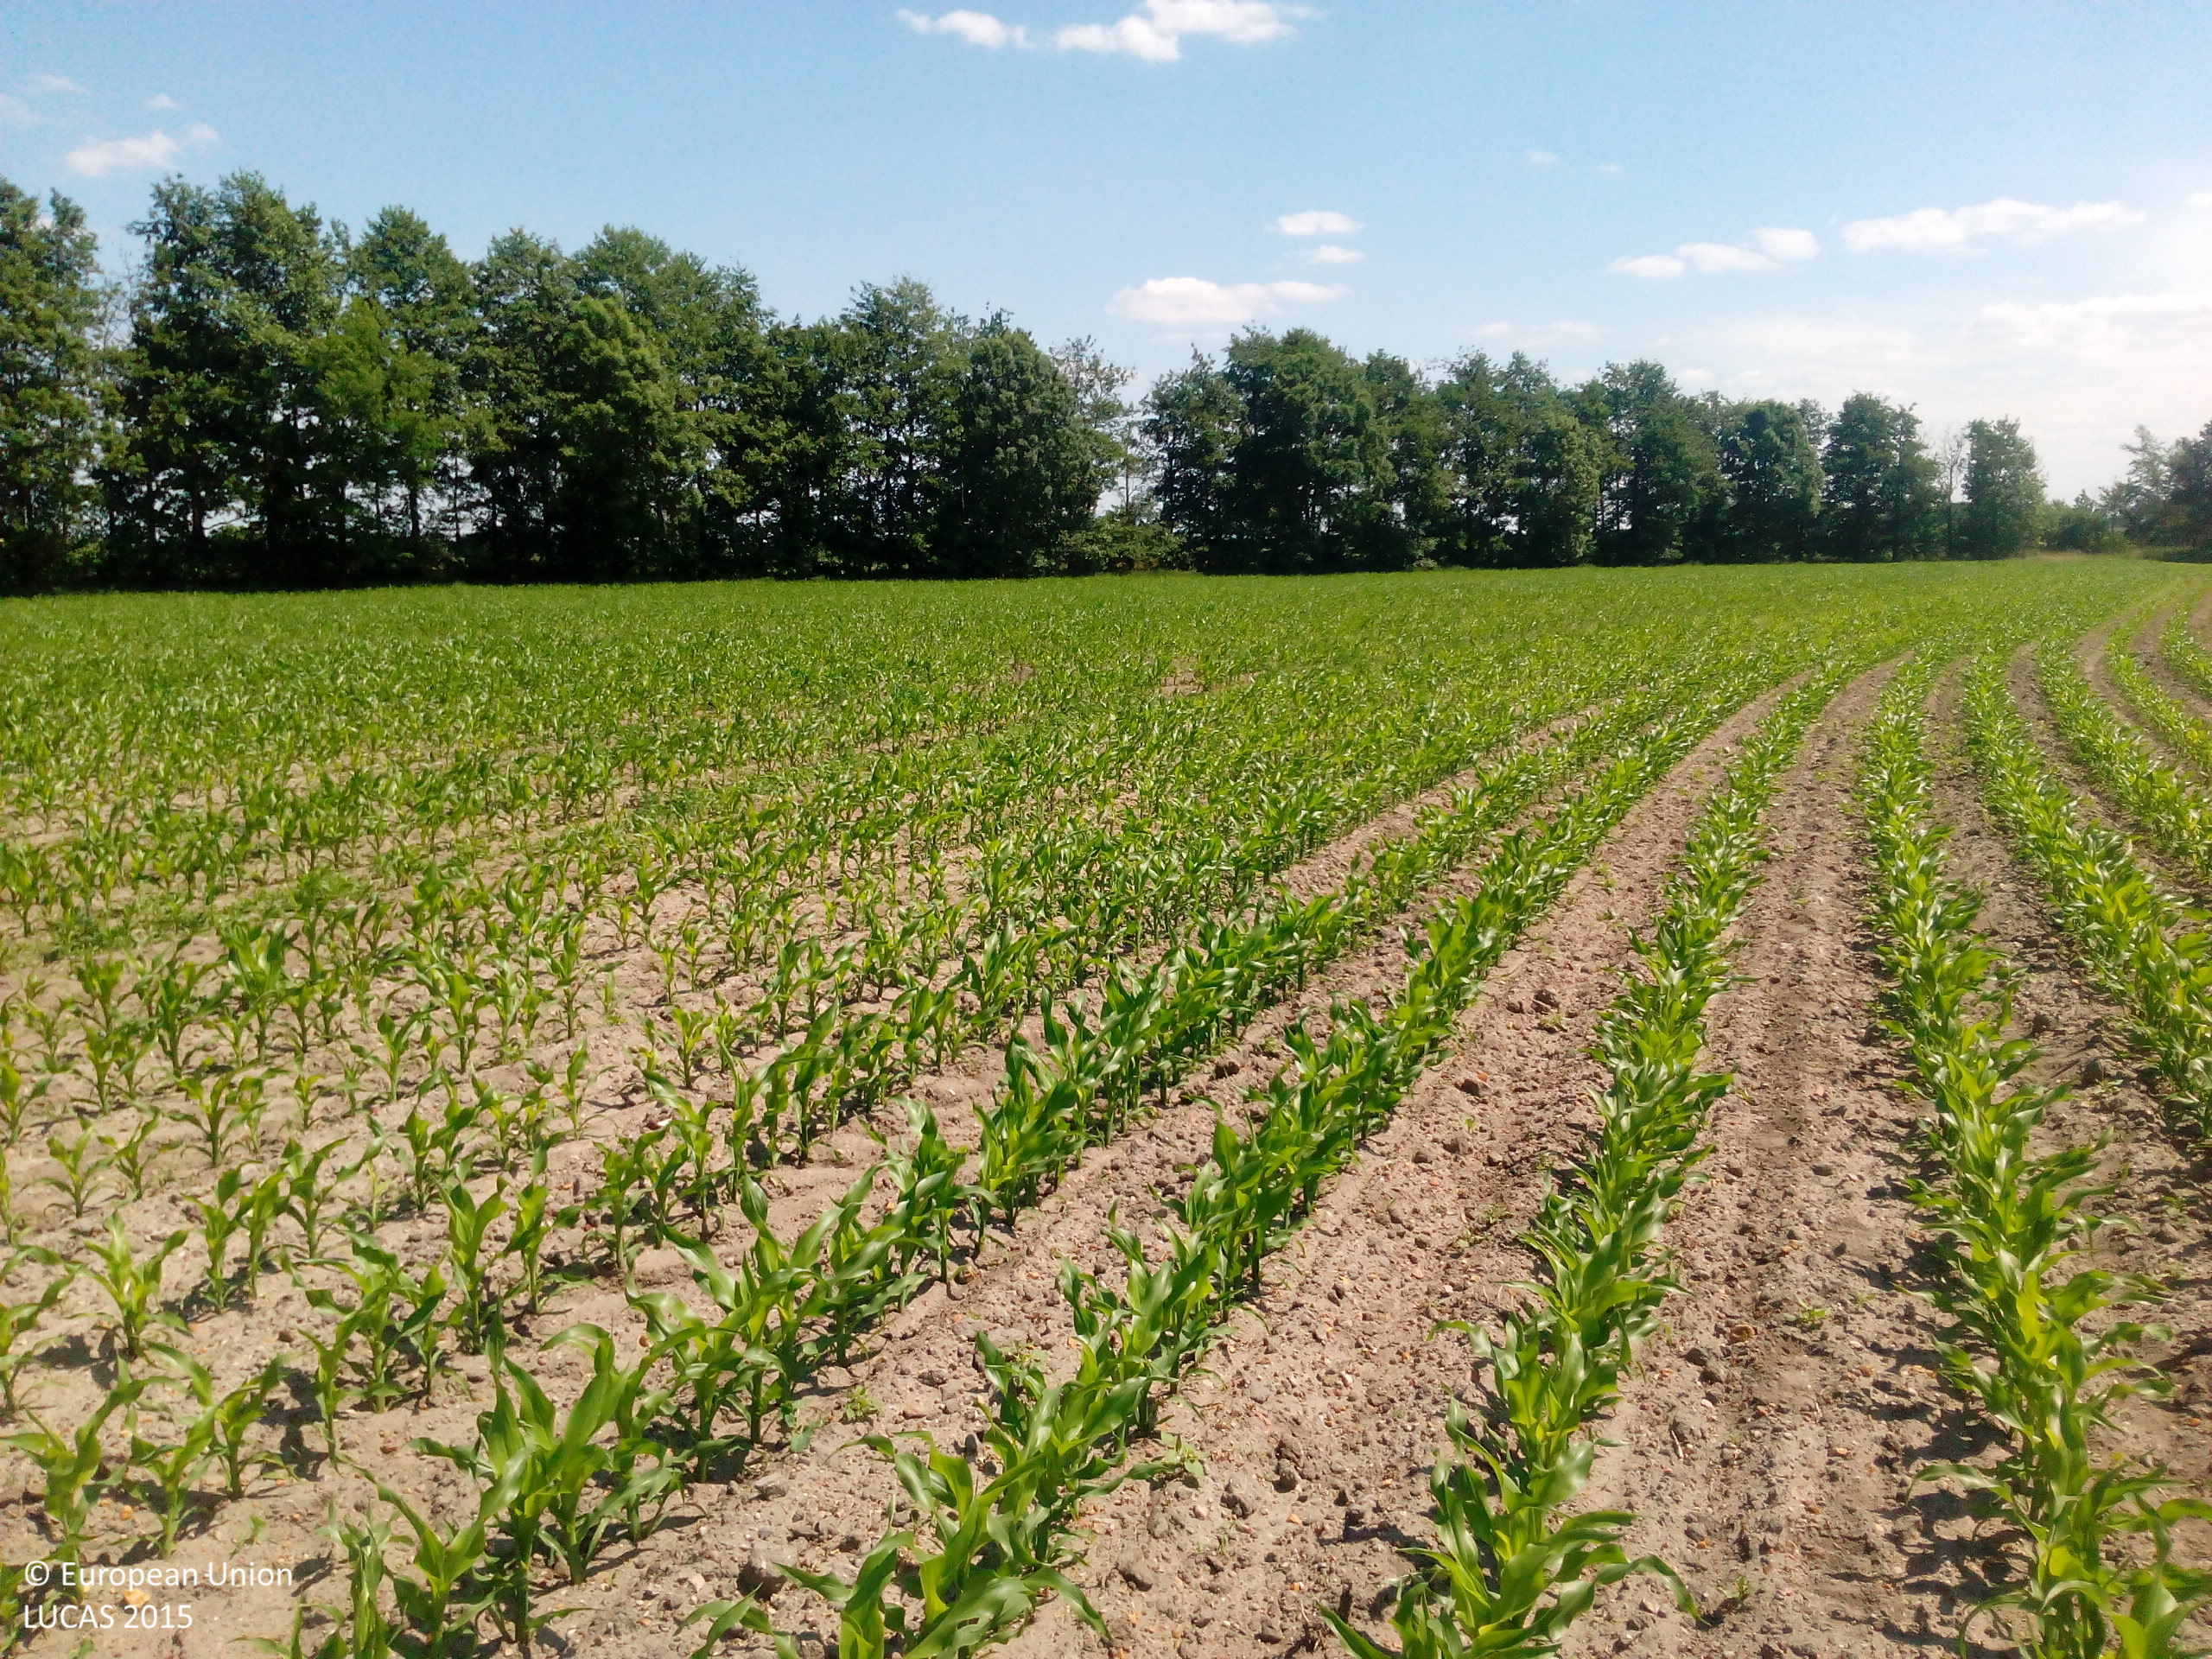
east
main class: Cropland
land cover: Maize
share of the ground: 10 - 25 %
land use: Agriculture (excluding fallow land and kitchen gardens)
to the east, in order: Maize; Broadleaved woodland; Ditches and canals; Grass margins; Tracks; Lines of trees; Fences; Grassland without tree/shrub cover
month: June
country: DE
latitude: 52.4080
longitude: 11.1315
